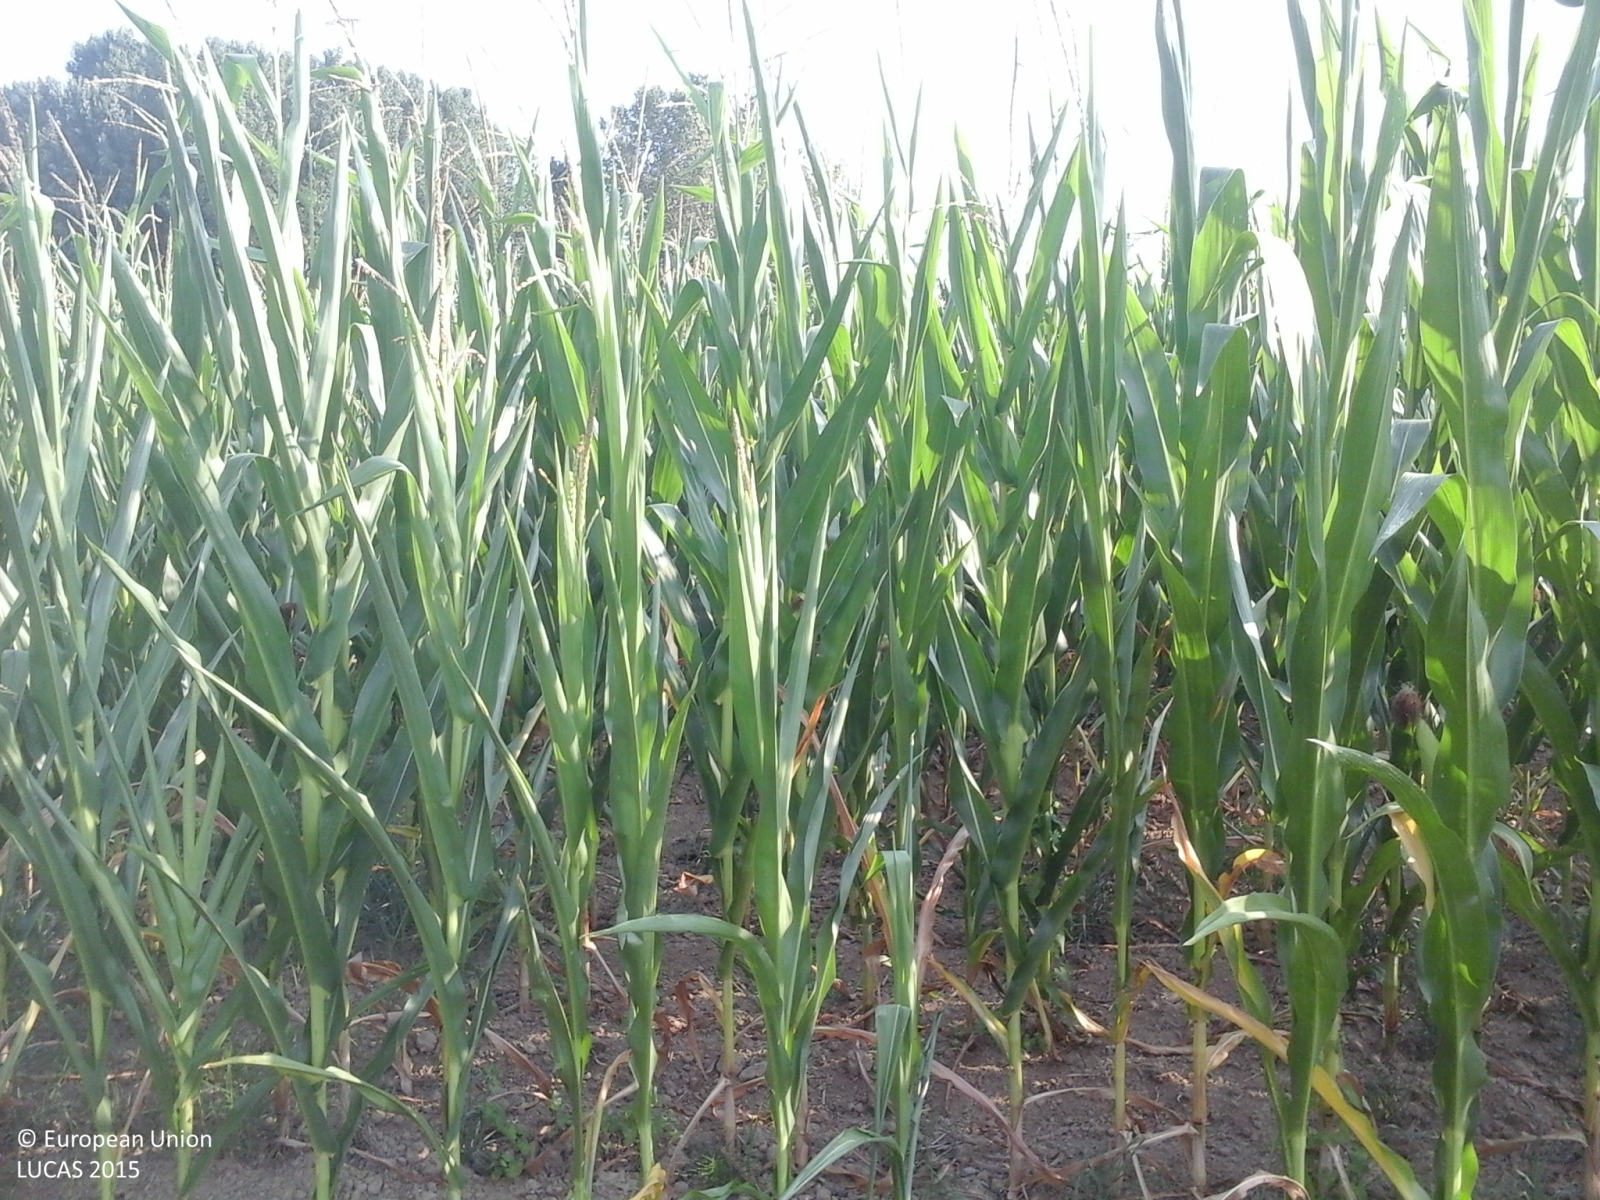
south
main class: Cropland
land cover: Maize
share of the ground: > 75 %
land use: Agriculture (excluding fallow land and kitchen gardens)
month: August
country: IT
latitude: 43.8438
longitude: 10.5831
